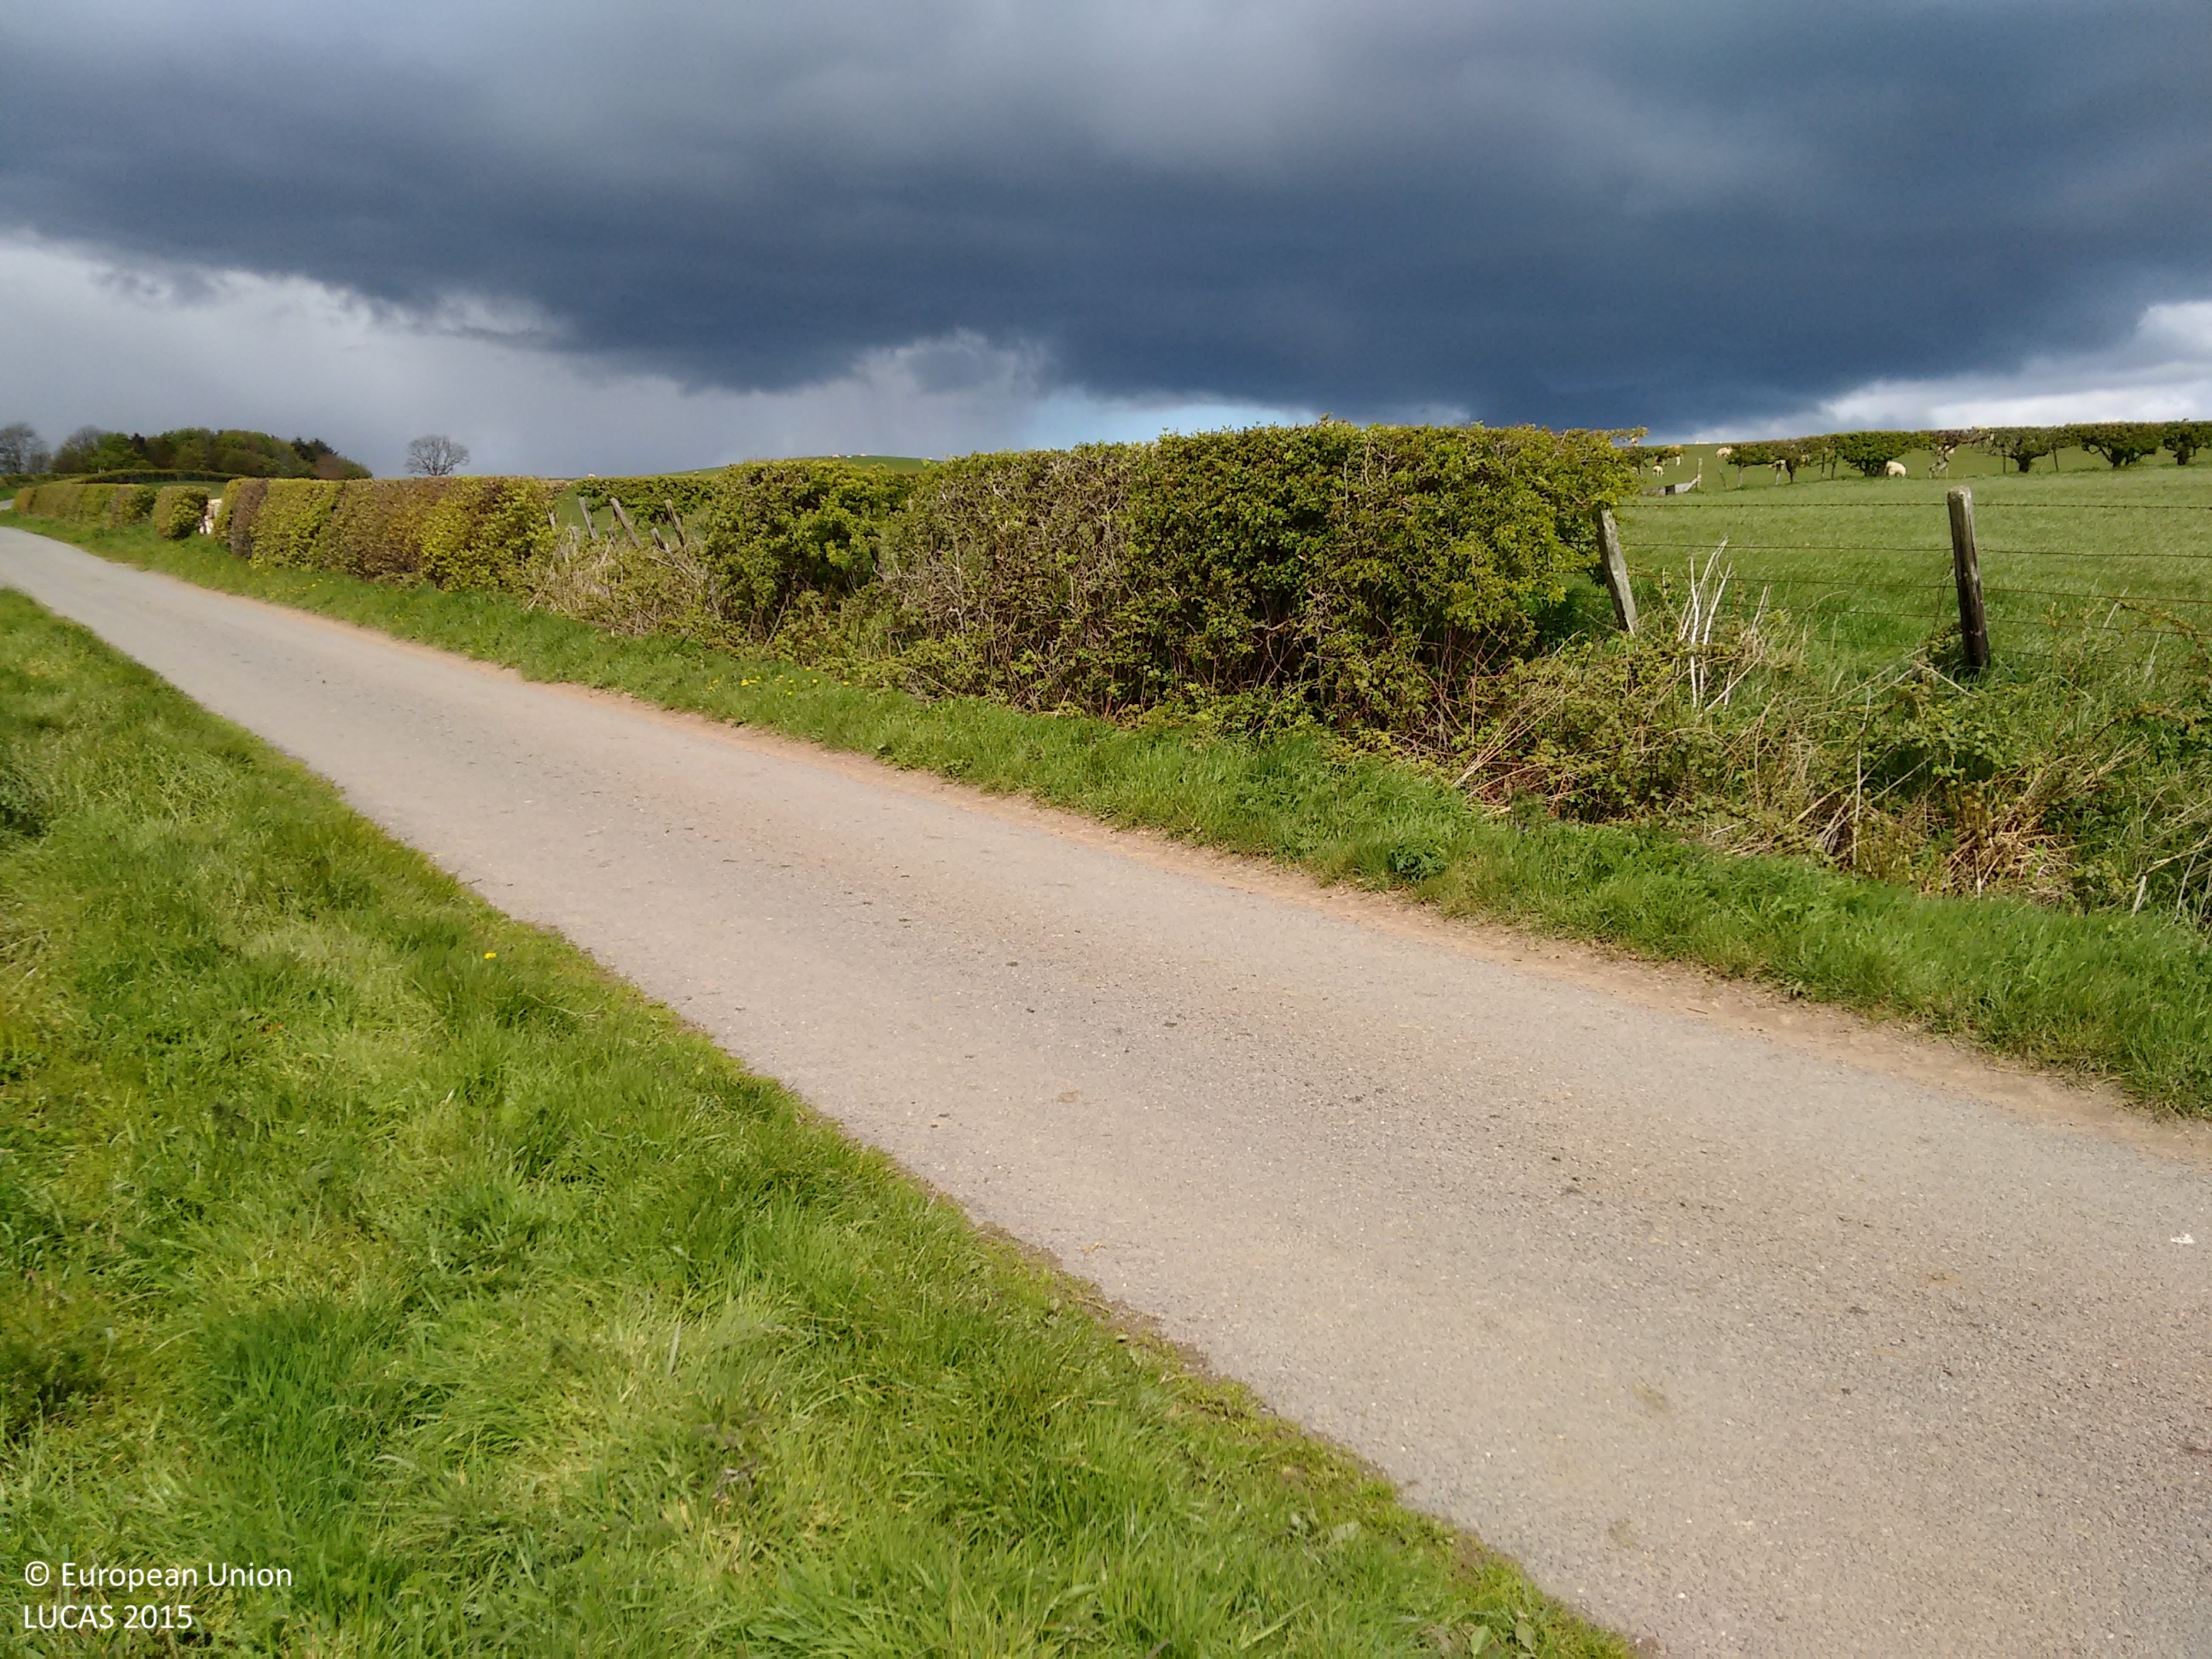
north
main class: Grassland
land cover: Grassland without tree/shrub cover
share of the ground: > 75 %
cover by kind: herbaceous plants 100 %
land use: Agriculture (excluding fallow land and kitchen gardens)
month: May
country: GB
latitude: 55.9120
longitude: -2.3925
